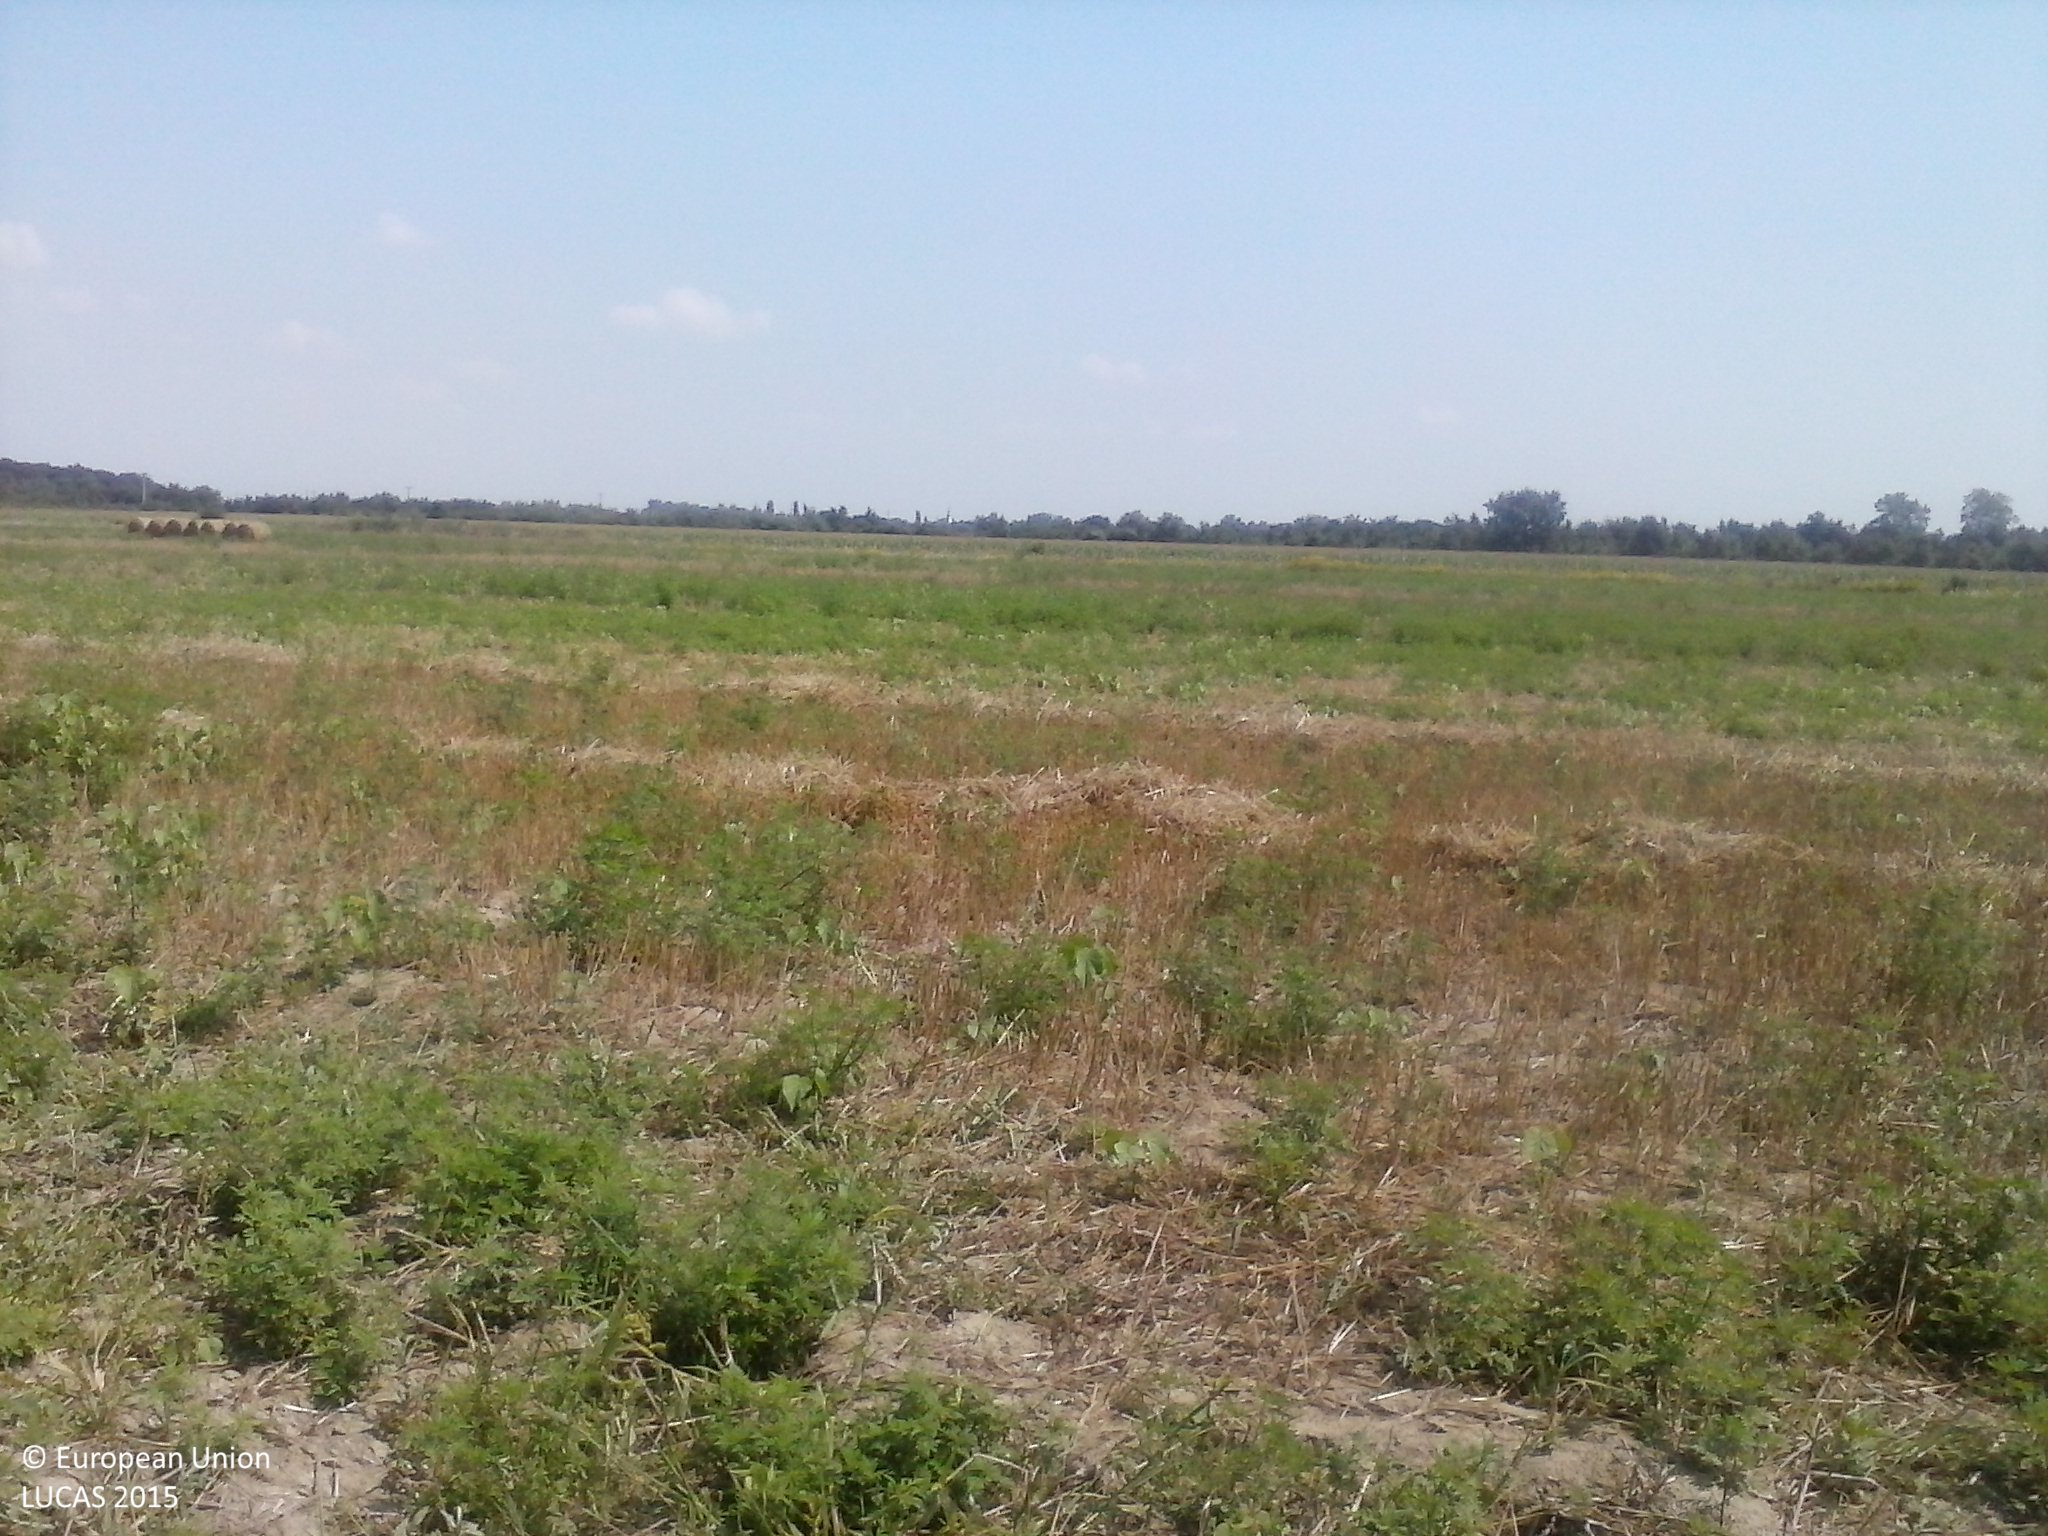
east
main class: Cropland
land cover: Triticale
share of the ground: 25 - 50 %
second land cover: Spontaneously vegetated surfaces
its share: 50 - 75 %
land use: Agriculture (excluding fallow land and kitchen gardens)
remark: Harvested field
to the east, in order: Triticale; Spontaneously vegetated surfaces; Grass margins; Tracks; Grass margins; Maize
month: August
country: HU
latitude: 45.9351
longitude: 17.8592
